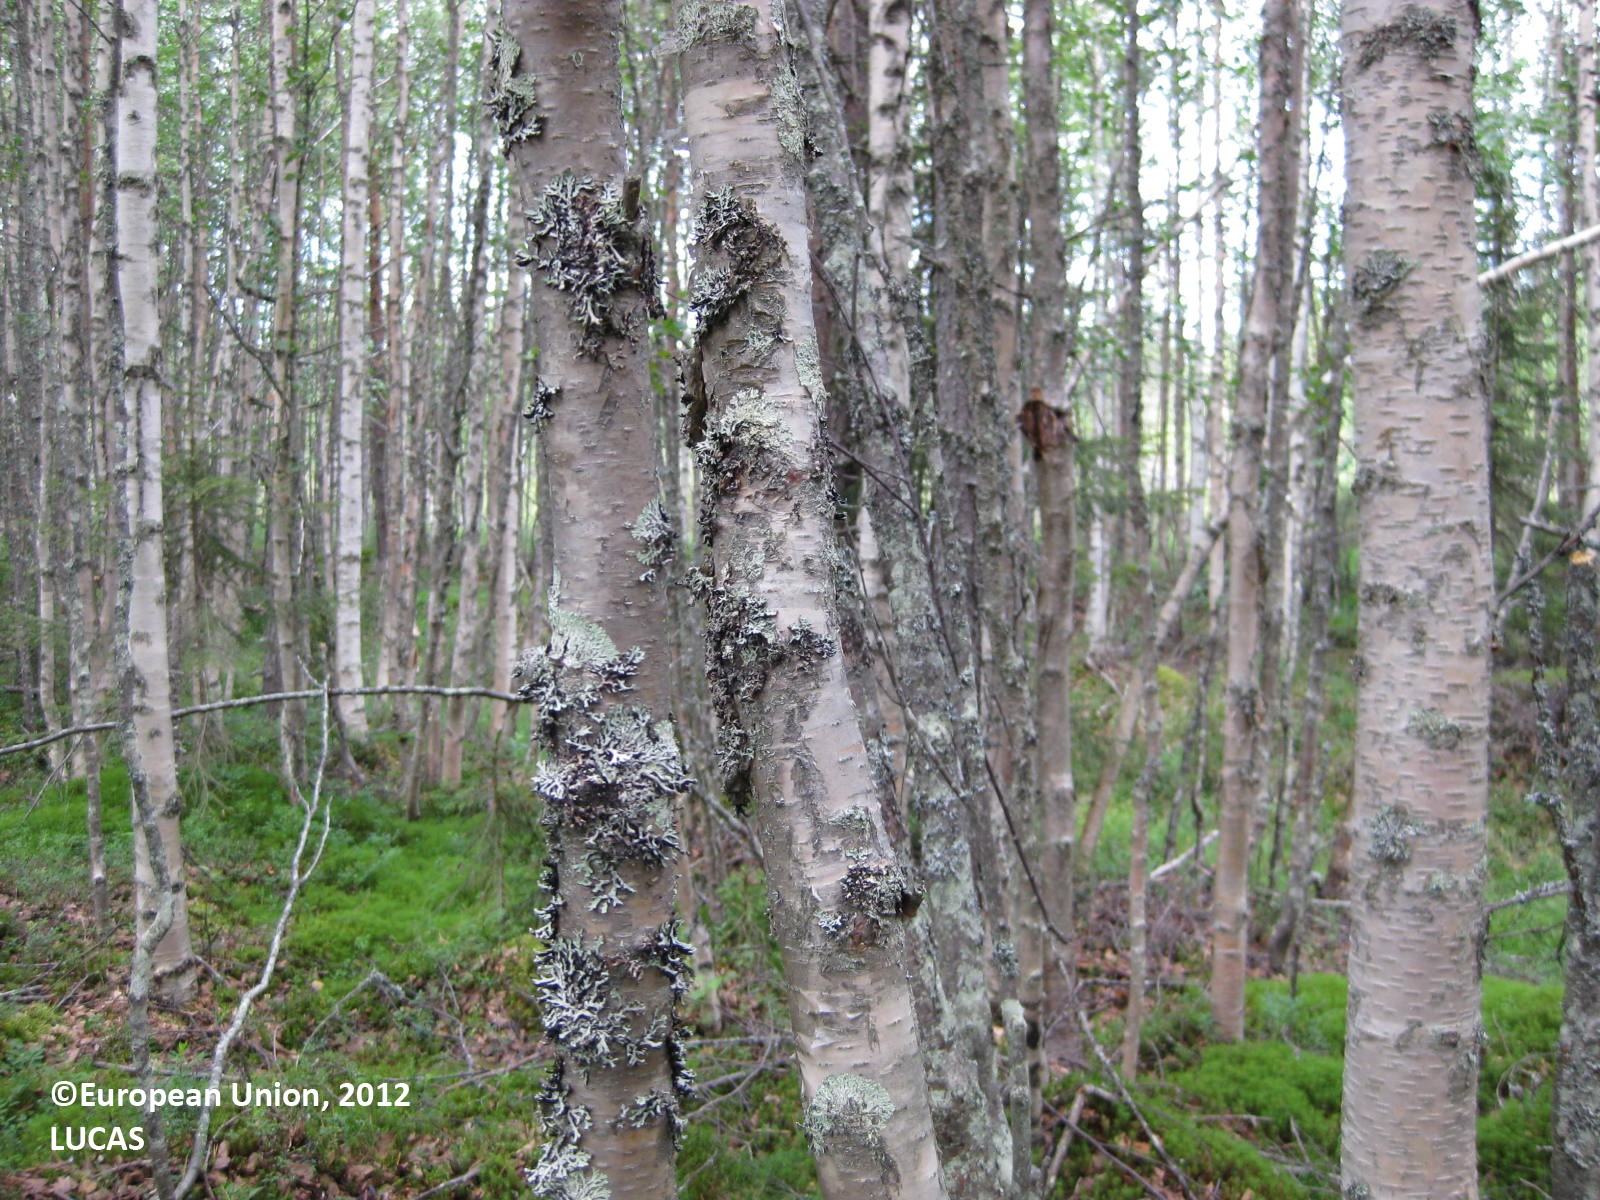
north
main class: Woodland
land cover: Pine dominated mixed woodland
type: boreal forest
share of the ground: > 75 %
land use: Forestry
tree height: > 5 m
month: August
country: FI
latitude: 66.4060
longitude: 28.4376
